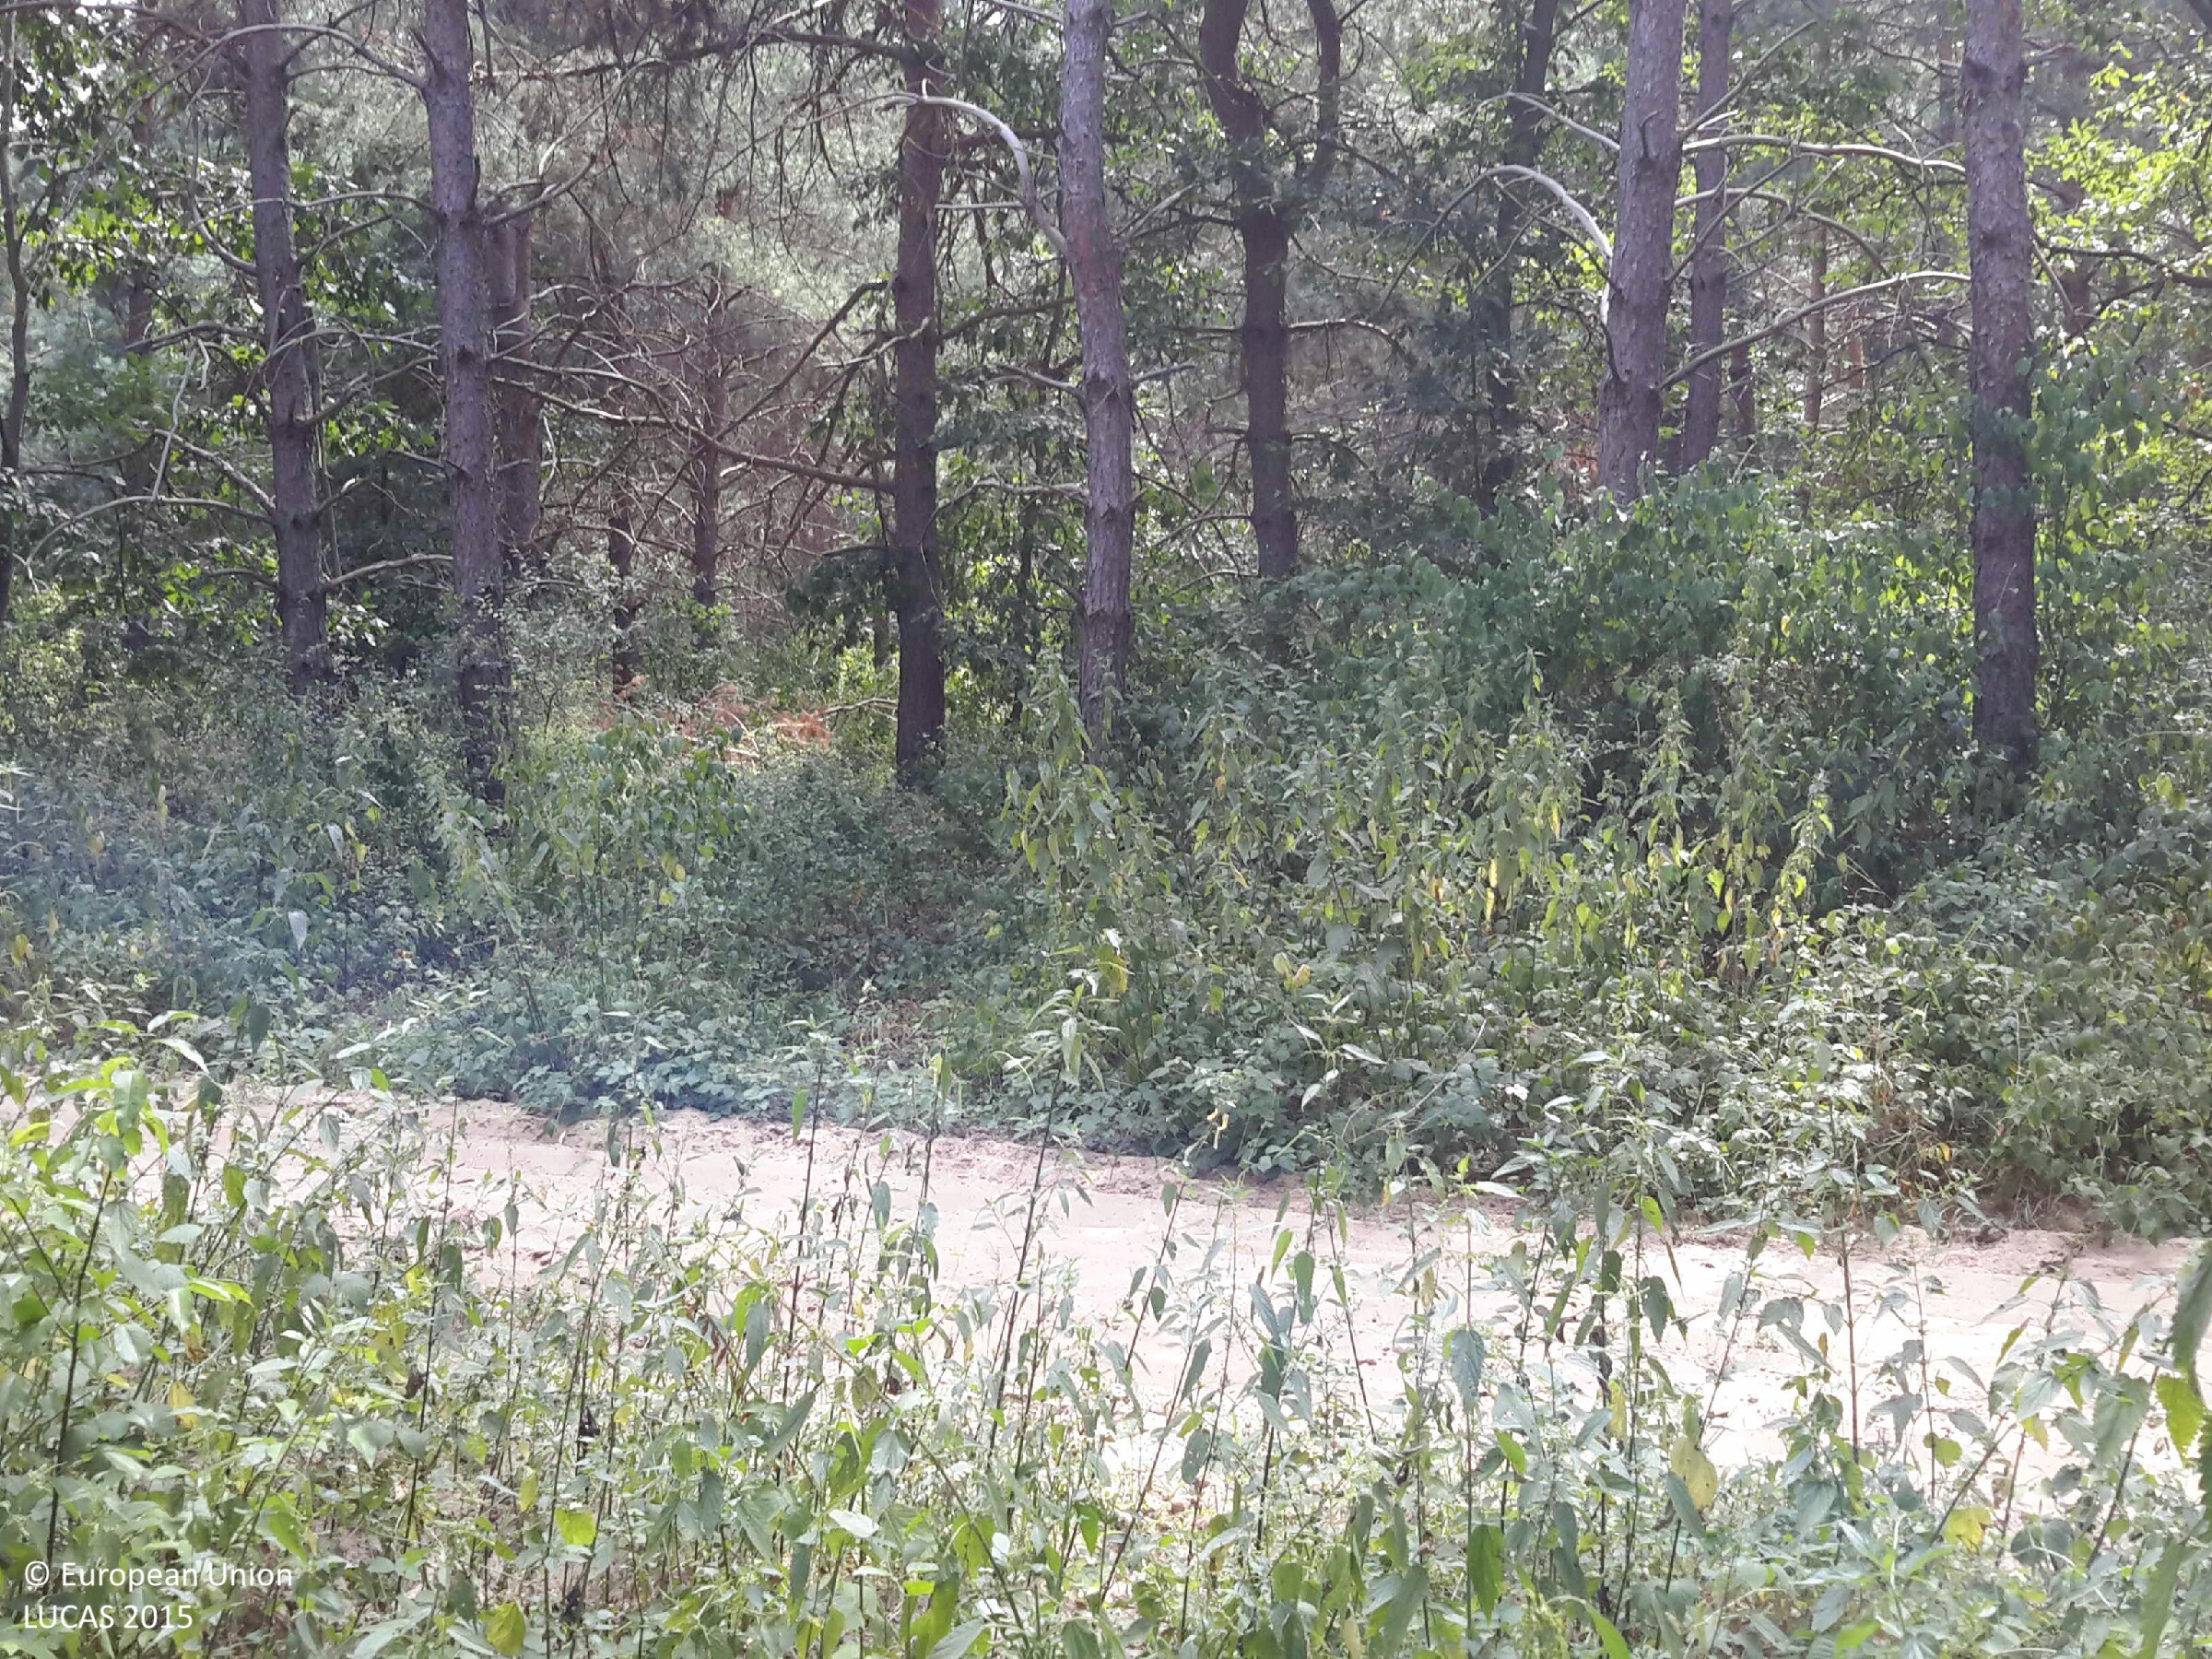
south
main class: Woodland
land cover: Spruce dominated coniferous woodland
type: hemiboreal forest and nemoral coniferous forest and mixed broadleaved-coniferous forest
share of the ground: > 75 %
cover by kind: coniferous forest trees 85 %, herbaceous plants 10 %, broadleaved forest trees 5 %
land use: Forestry
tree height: > 5 m
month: July
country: HU
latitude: 47.3536
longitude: 17.7535
